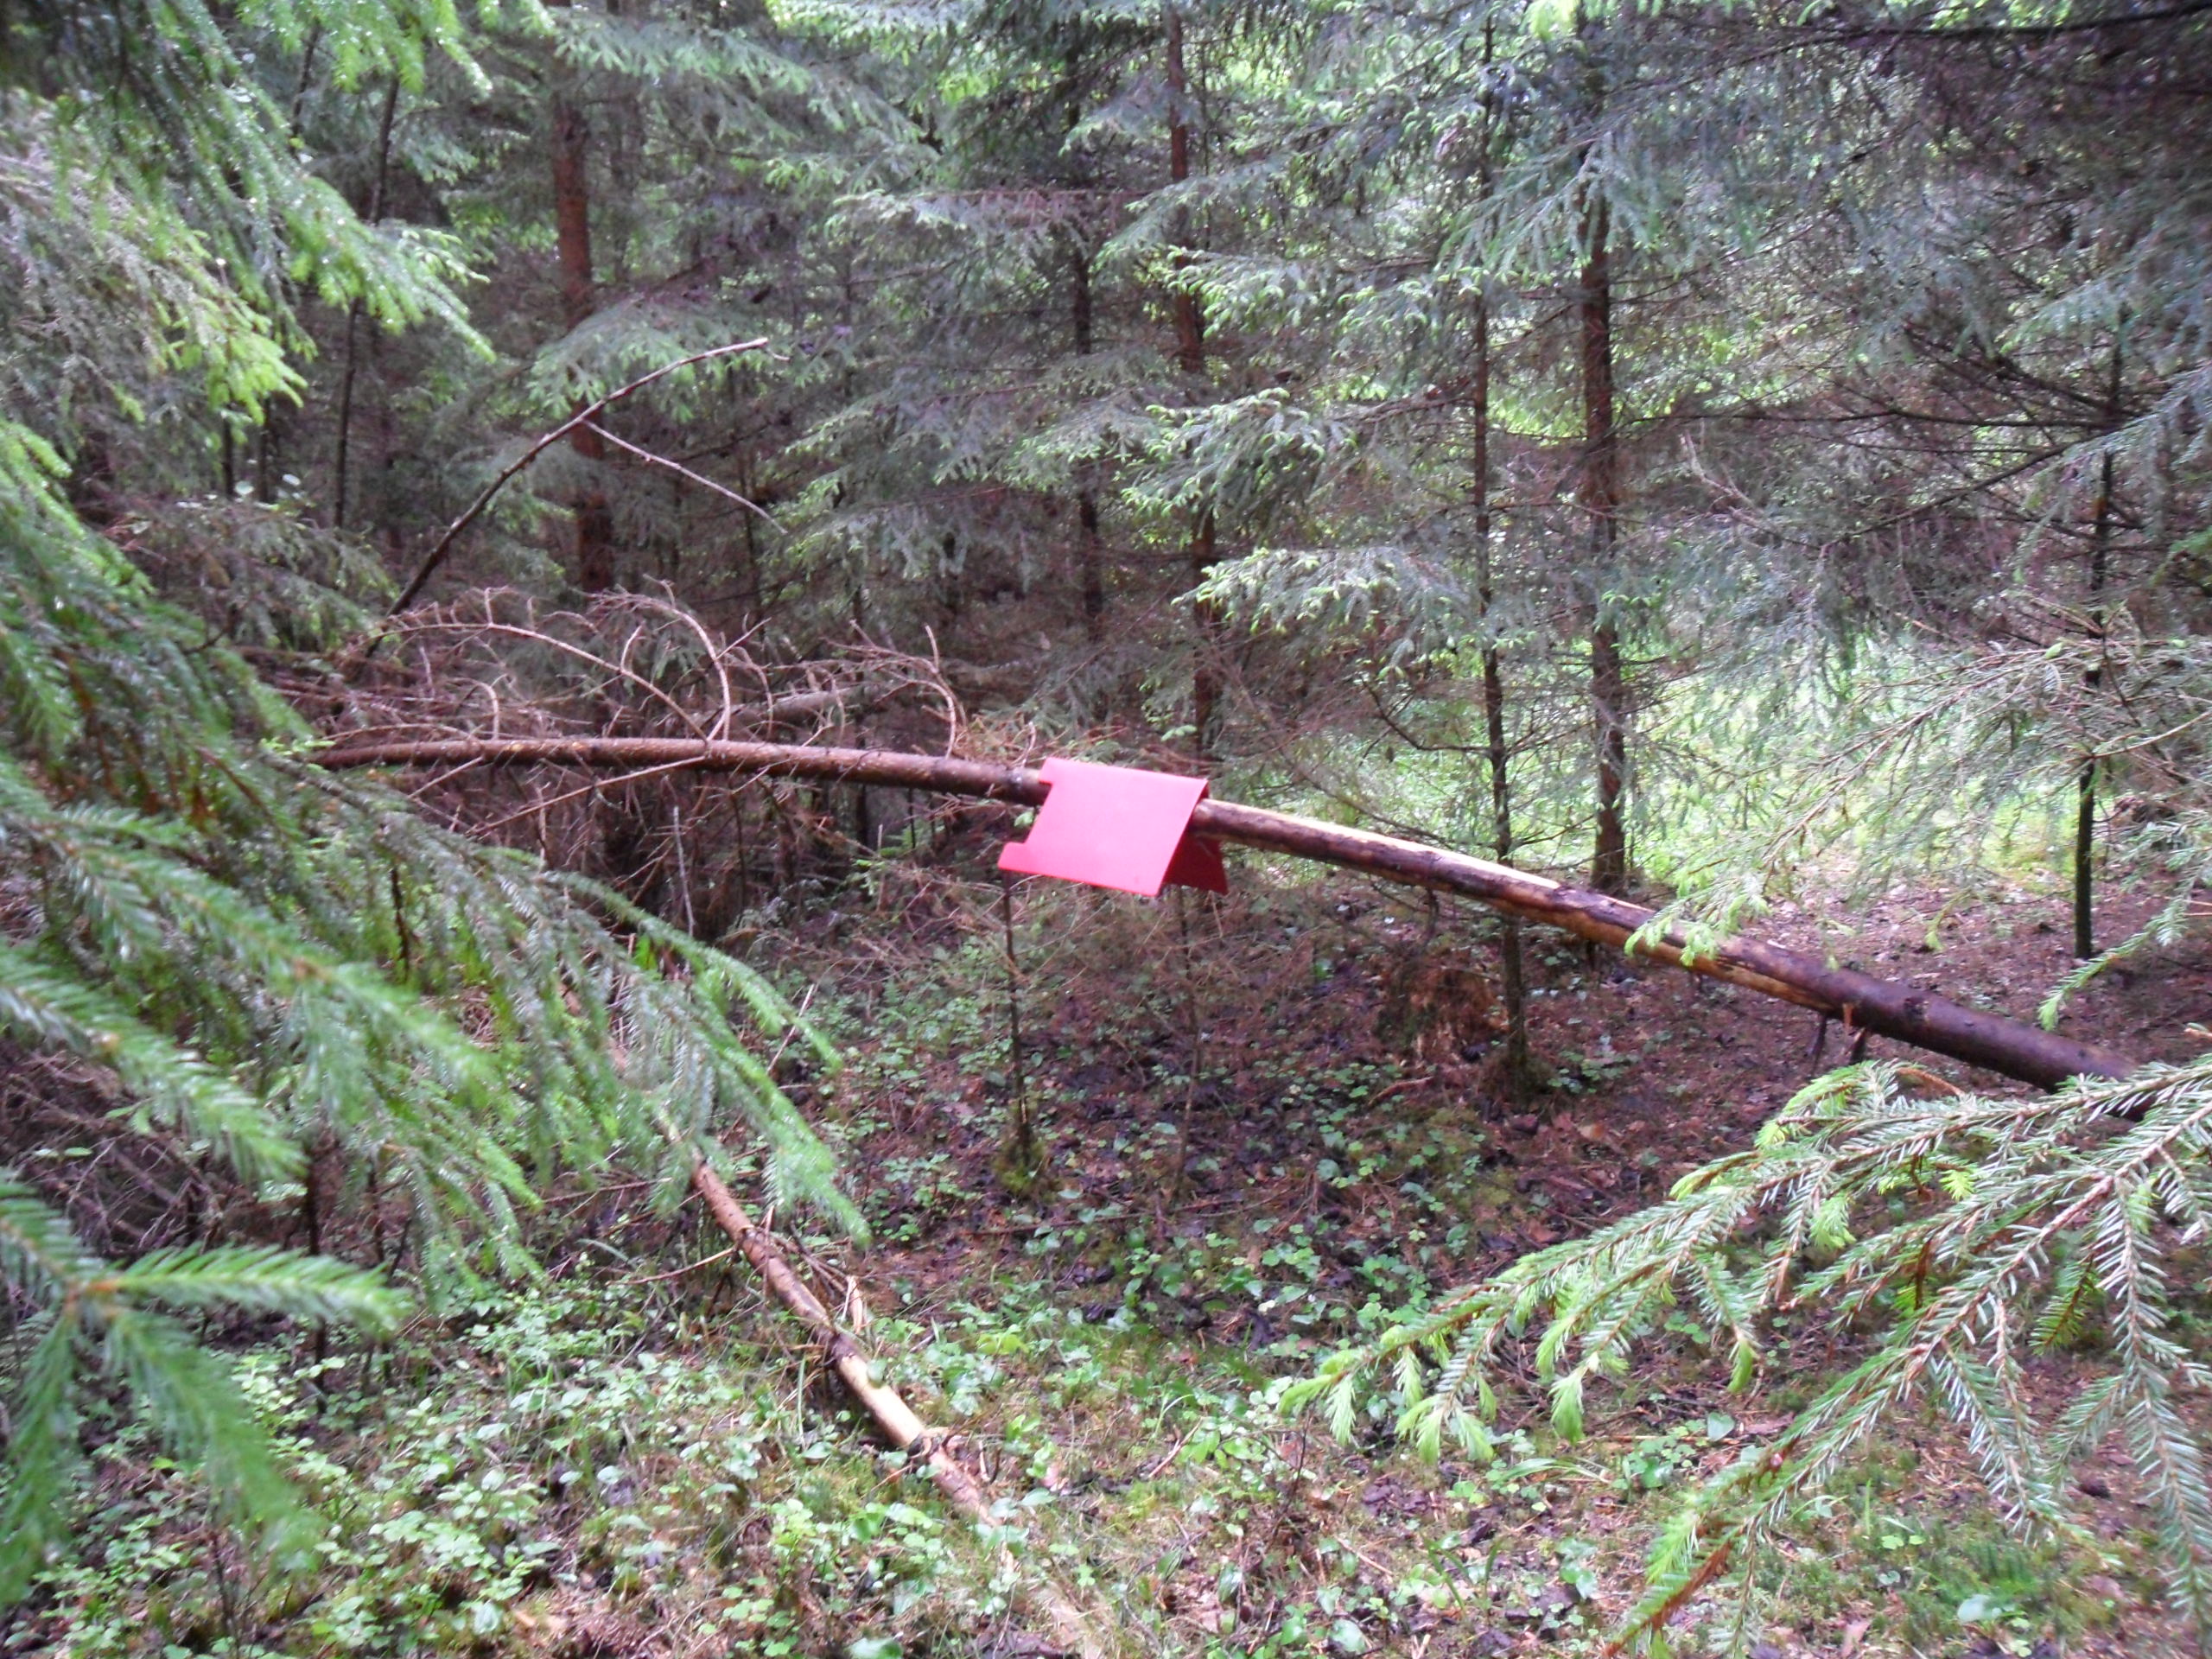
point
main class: Woodland
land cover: Spruce dominated coniferous woodland
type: hemiboreal forest and nemoral coniferous forest and mixed broadleaved-coniferous forest
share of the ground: > 75 %
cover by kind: coniferous forest trees 80 %, herbaceous plants 10 %, lichens and mosses 10 %
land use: Forestry
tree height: > 5 m
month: June
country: LV
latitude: 57.3814
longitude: 22.0725
